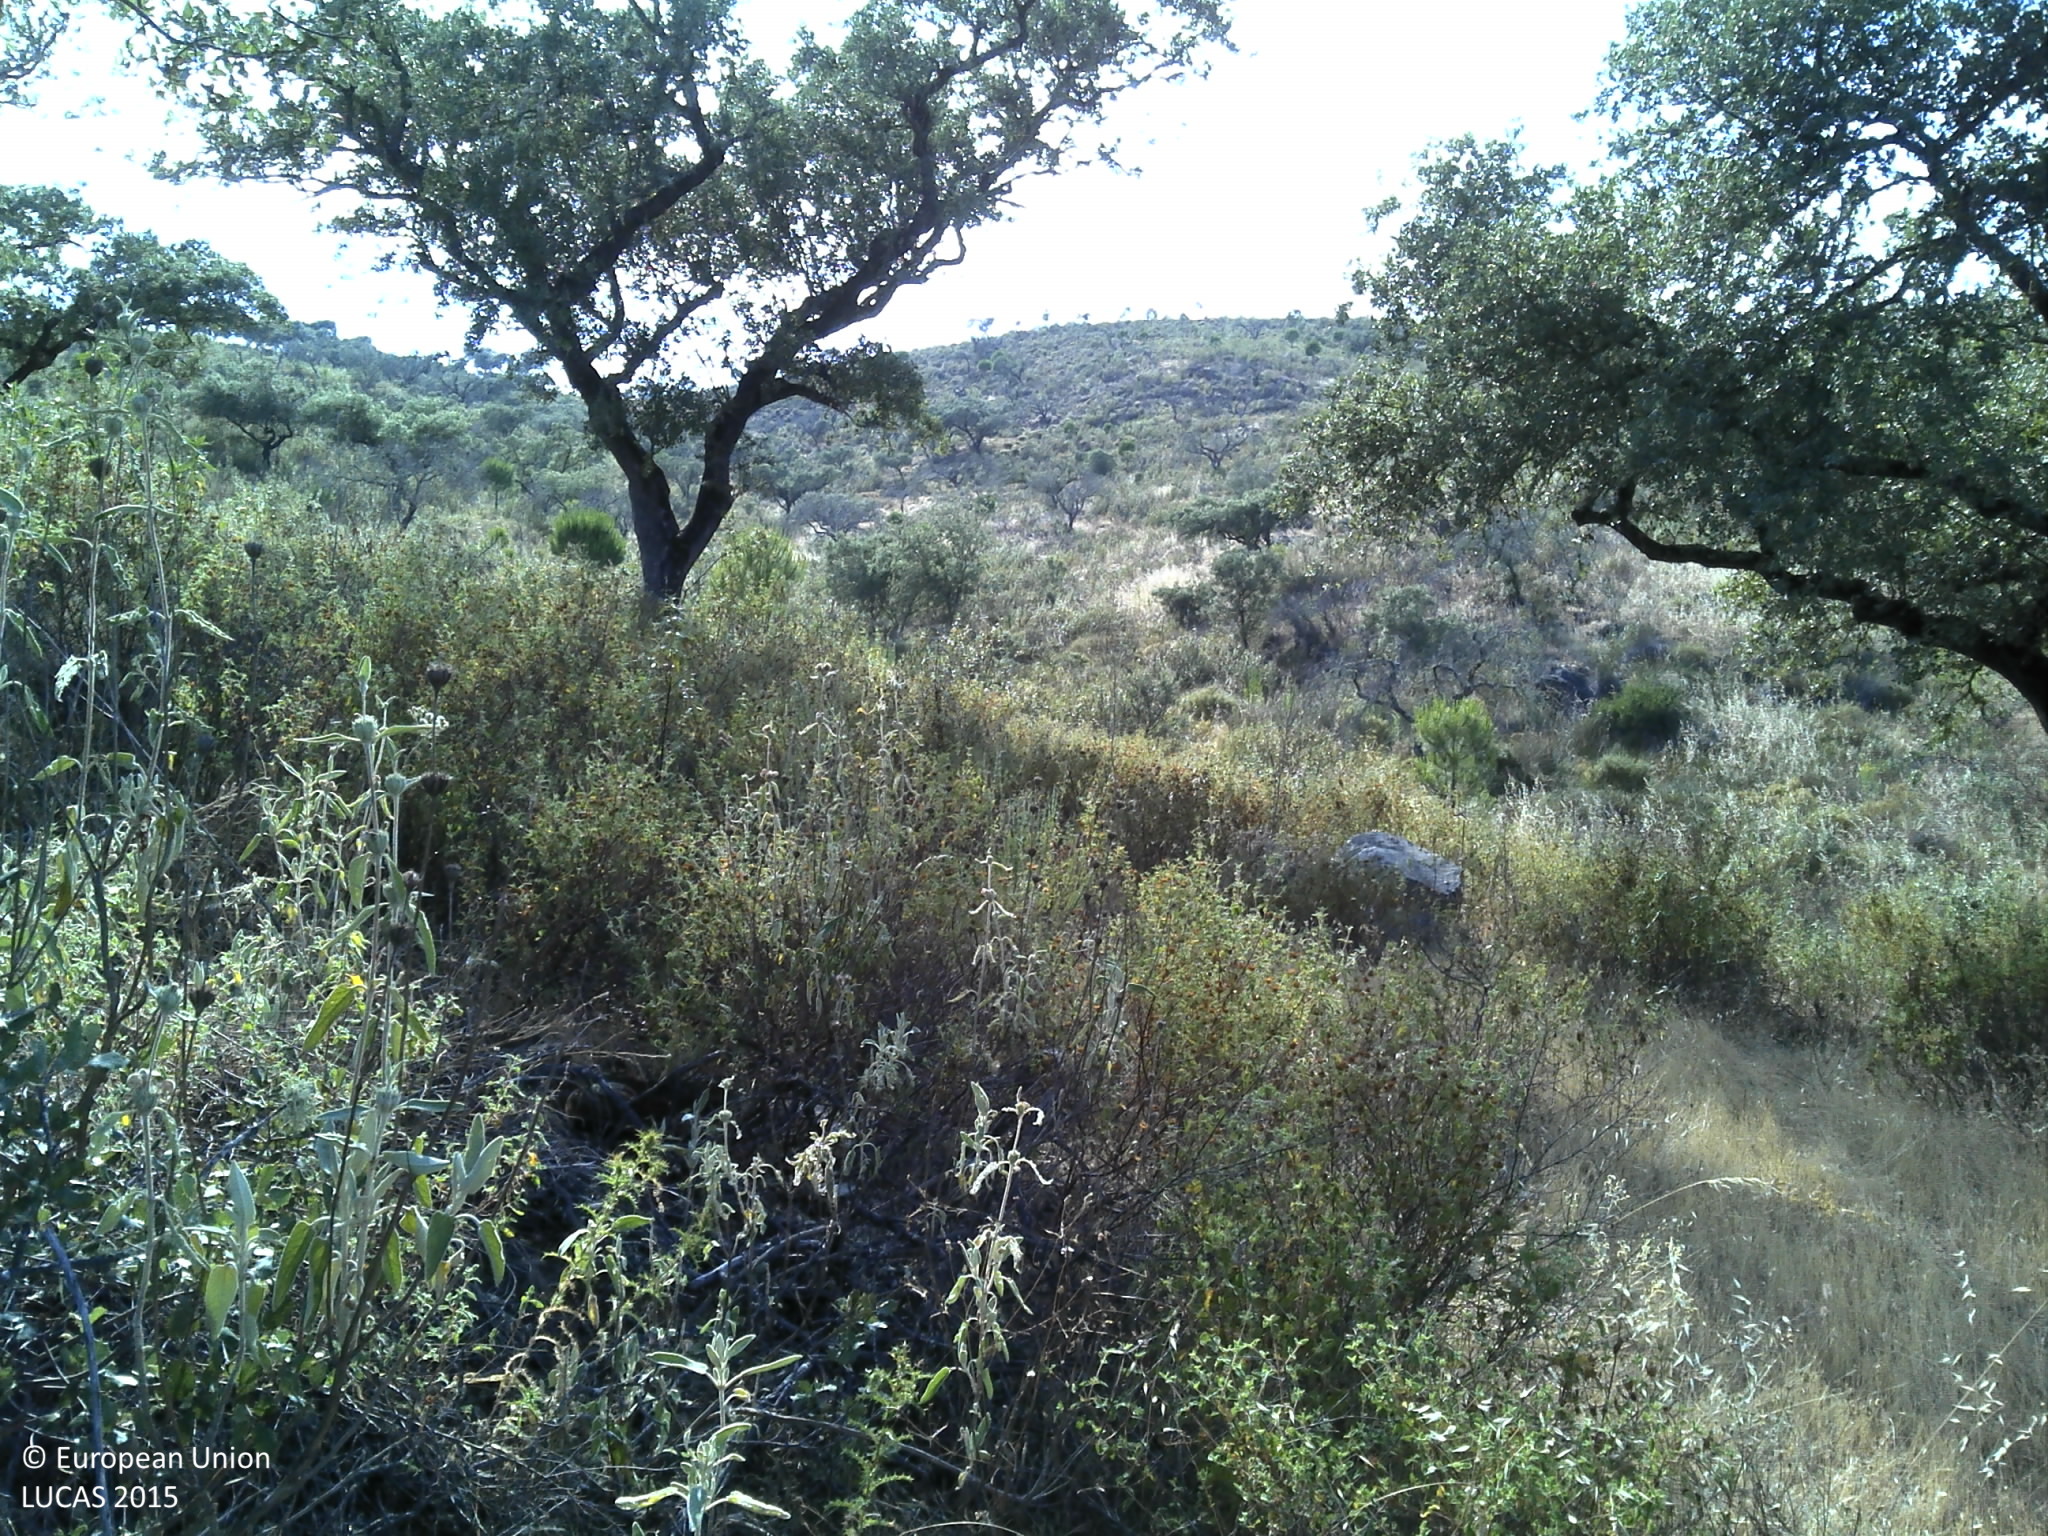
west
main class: Woodland
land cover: Broadleaved woodland
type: broadleaved evergreen forest
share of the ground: 25 - 50 %
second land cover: Shrubland without tree cover
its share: 50 - 75 %
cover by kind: shrubs 50 %, broadleaved forest trees 45 %, herbaceous plants 5 %
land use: Forestry
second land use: Agriculture (excluding fallow land and kitchen gardens)
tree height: < 5 m
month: June
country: PT
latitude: 37.7113
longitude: -7.4474
